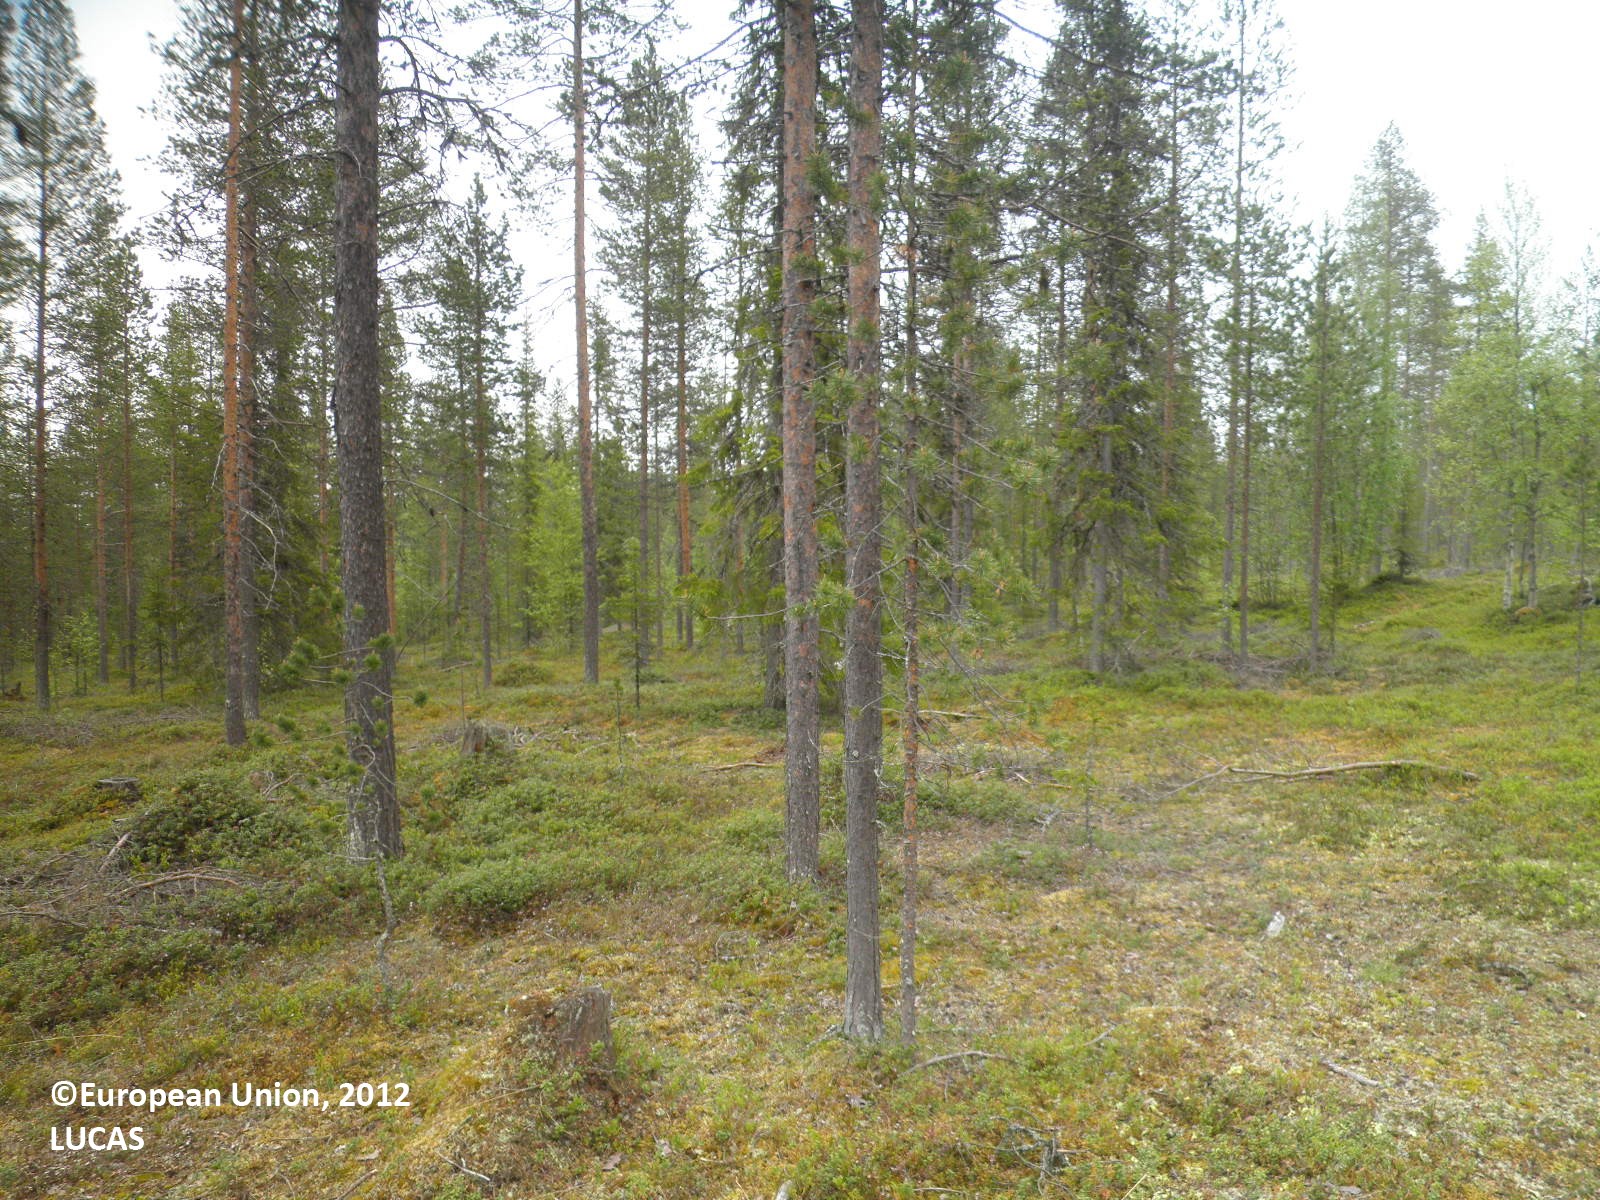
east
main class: Woodland
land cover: Pine dominated coniferous woodland
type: boreal forest
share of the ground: 25 - 50 %
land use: Forestry
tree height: > 5 m
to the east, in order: Pine dominated coniferous woodland; Pine dominated mixed woodland; Pine dominated coniferous woodland
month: June
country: FI
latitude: 67.8474
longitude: 25.3691
